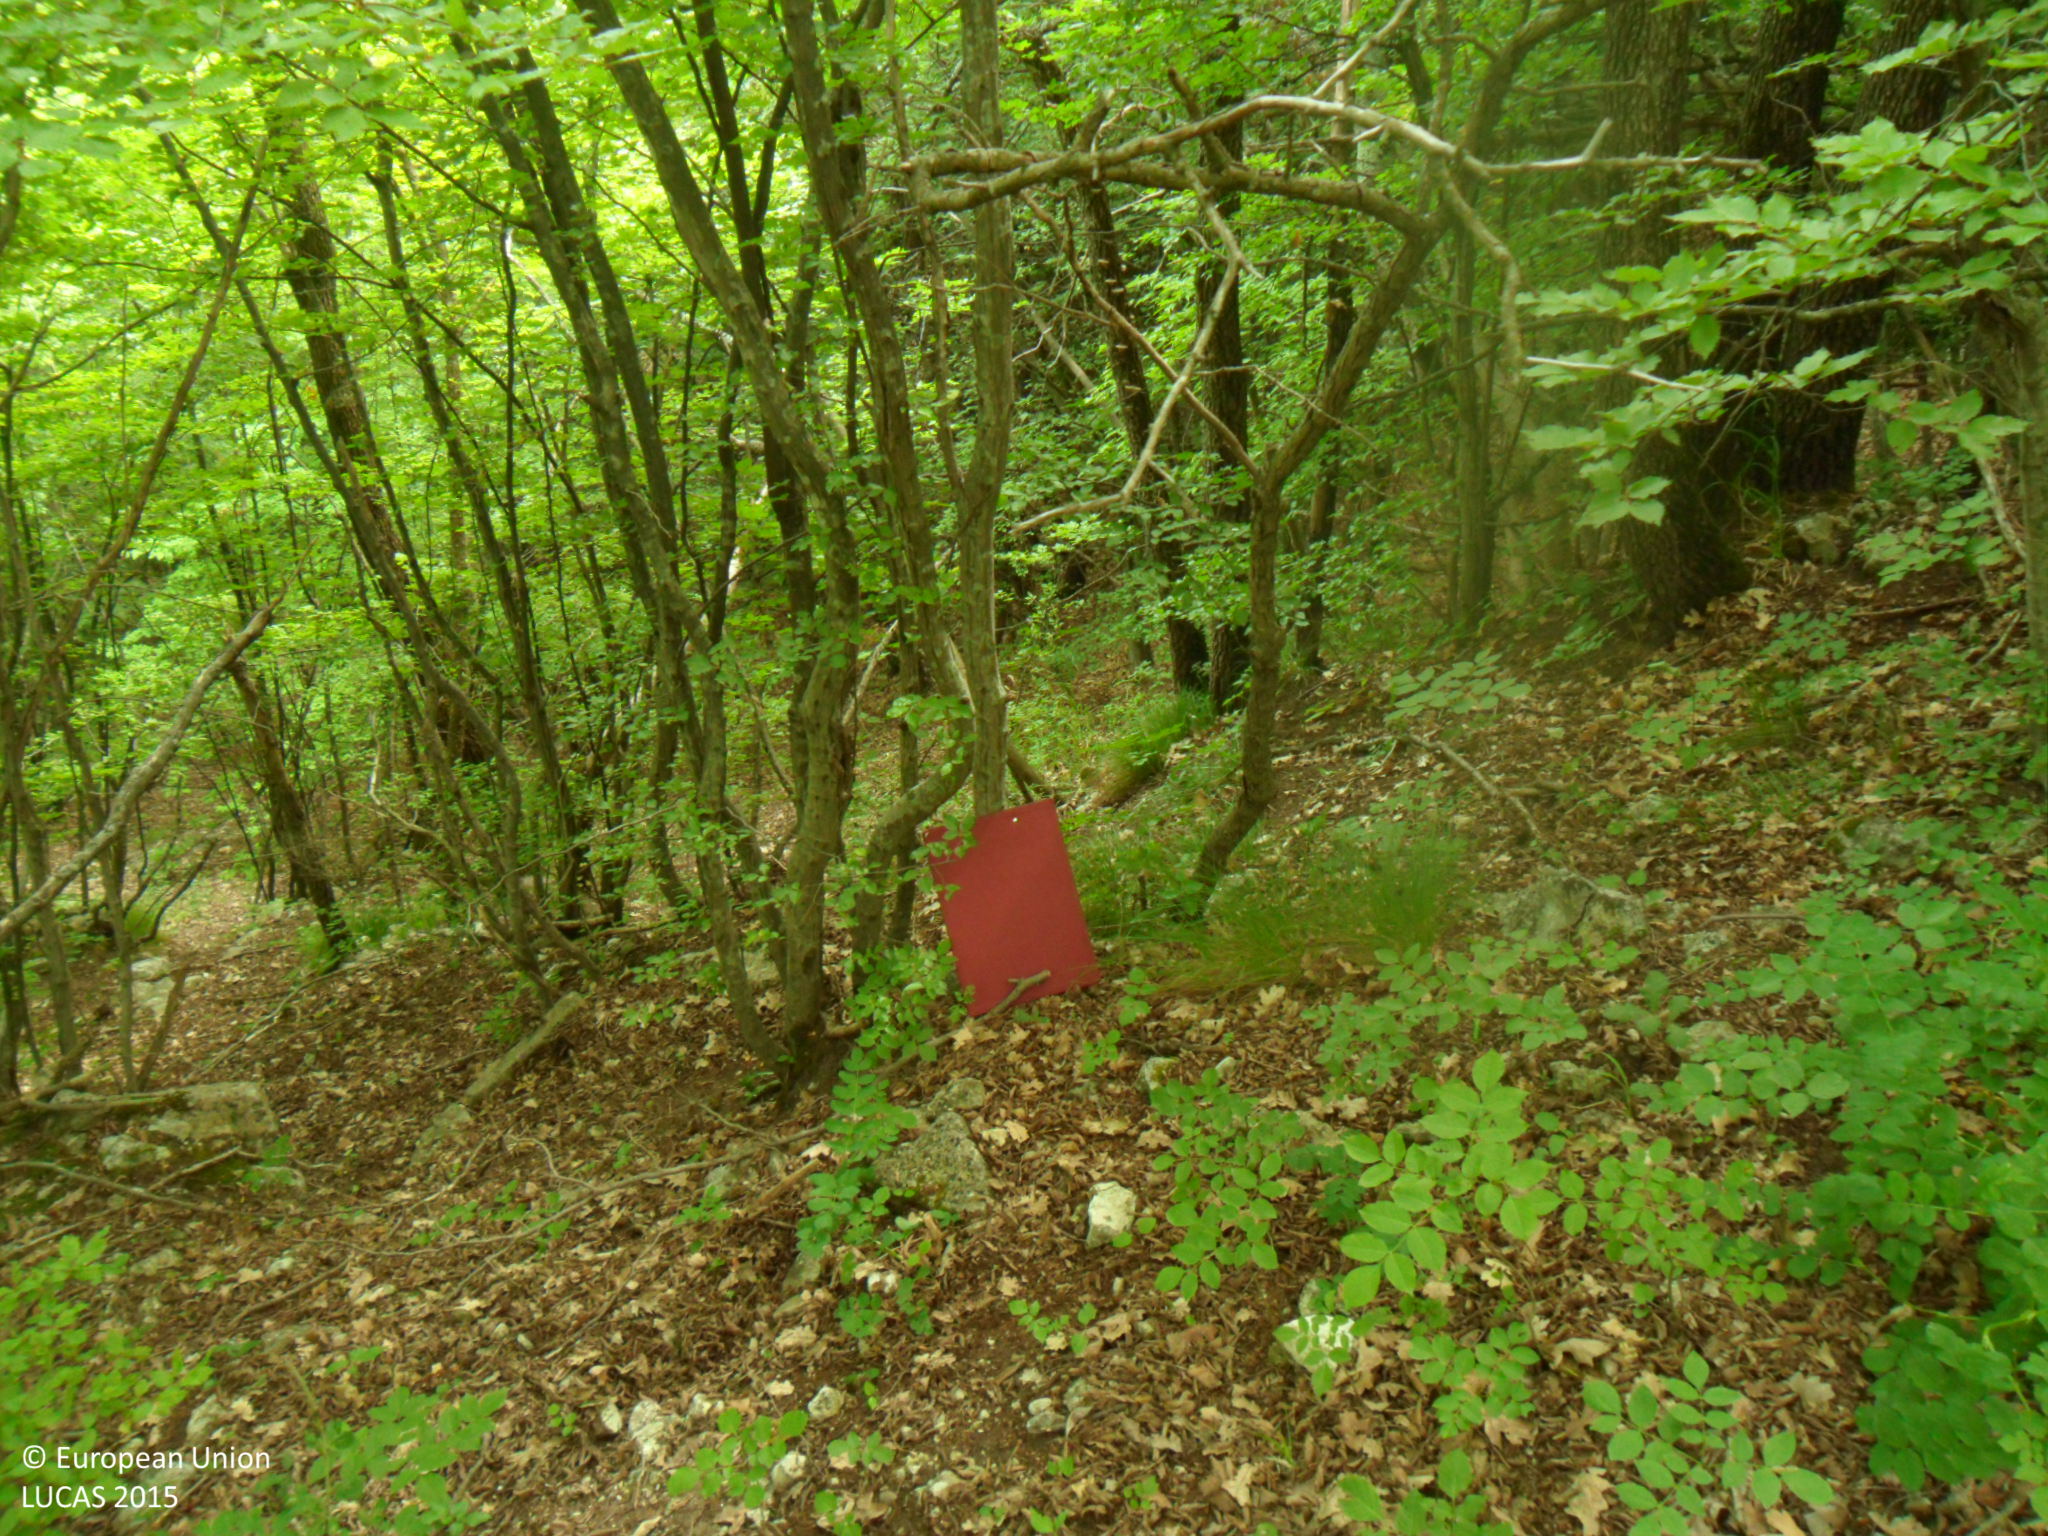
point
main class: Woodland
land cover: Broadleaved woodland
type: beech forest
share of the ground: > 75 %
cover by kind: broadleaved forest trees 100 %
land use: Forestry
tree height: > 5 m
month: June
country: BG
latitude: 43.3195
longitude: 26.7934
